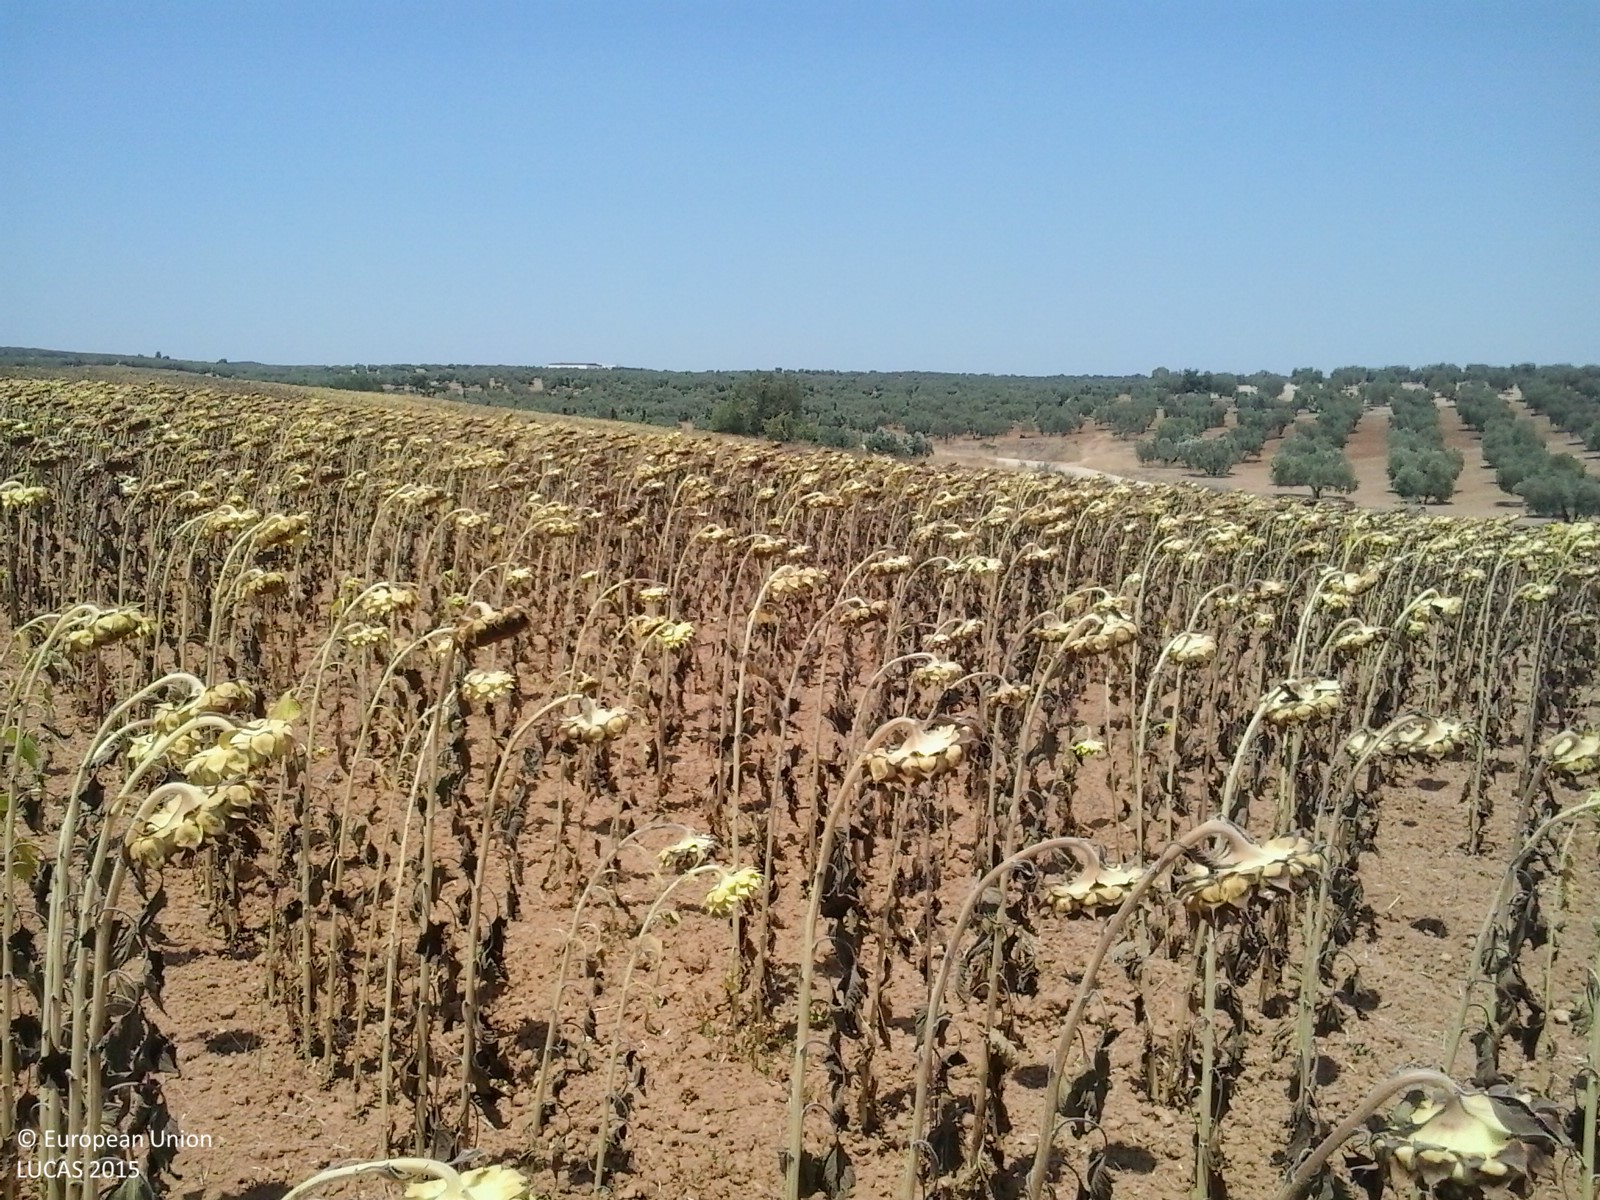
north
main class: Cropland
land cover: Sunflower
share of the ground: 25 - 50 %
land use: Agriculture (excluding fallow land and kitchen gardens)
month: July
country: ES
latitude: 37.4727
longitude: -6.4171
